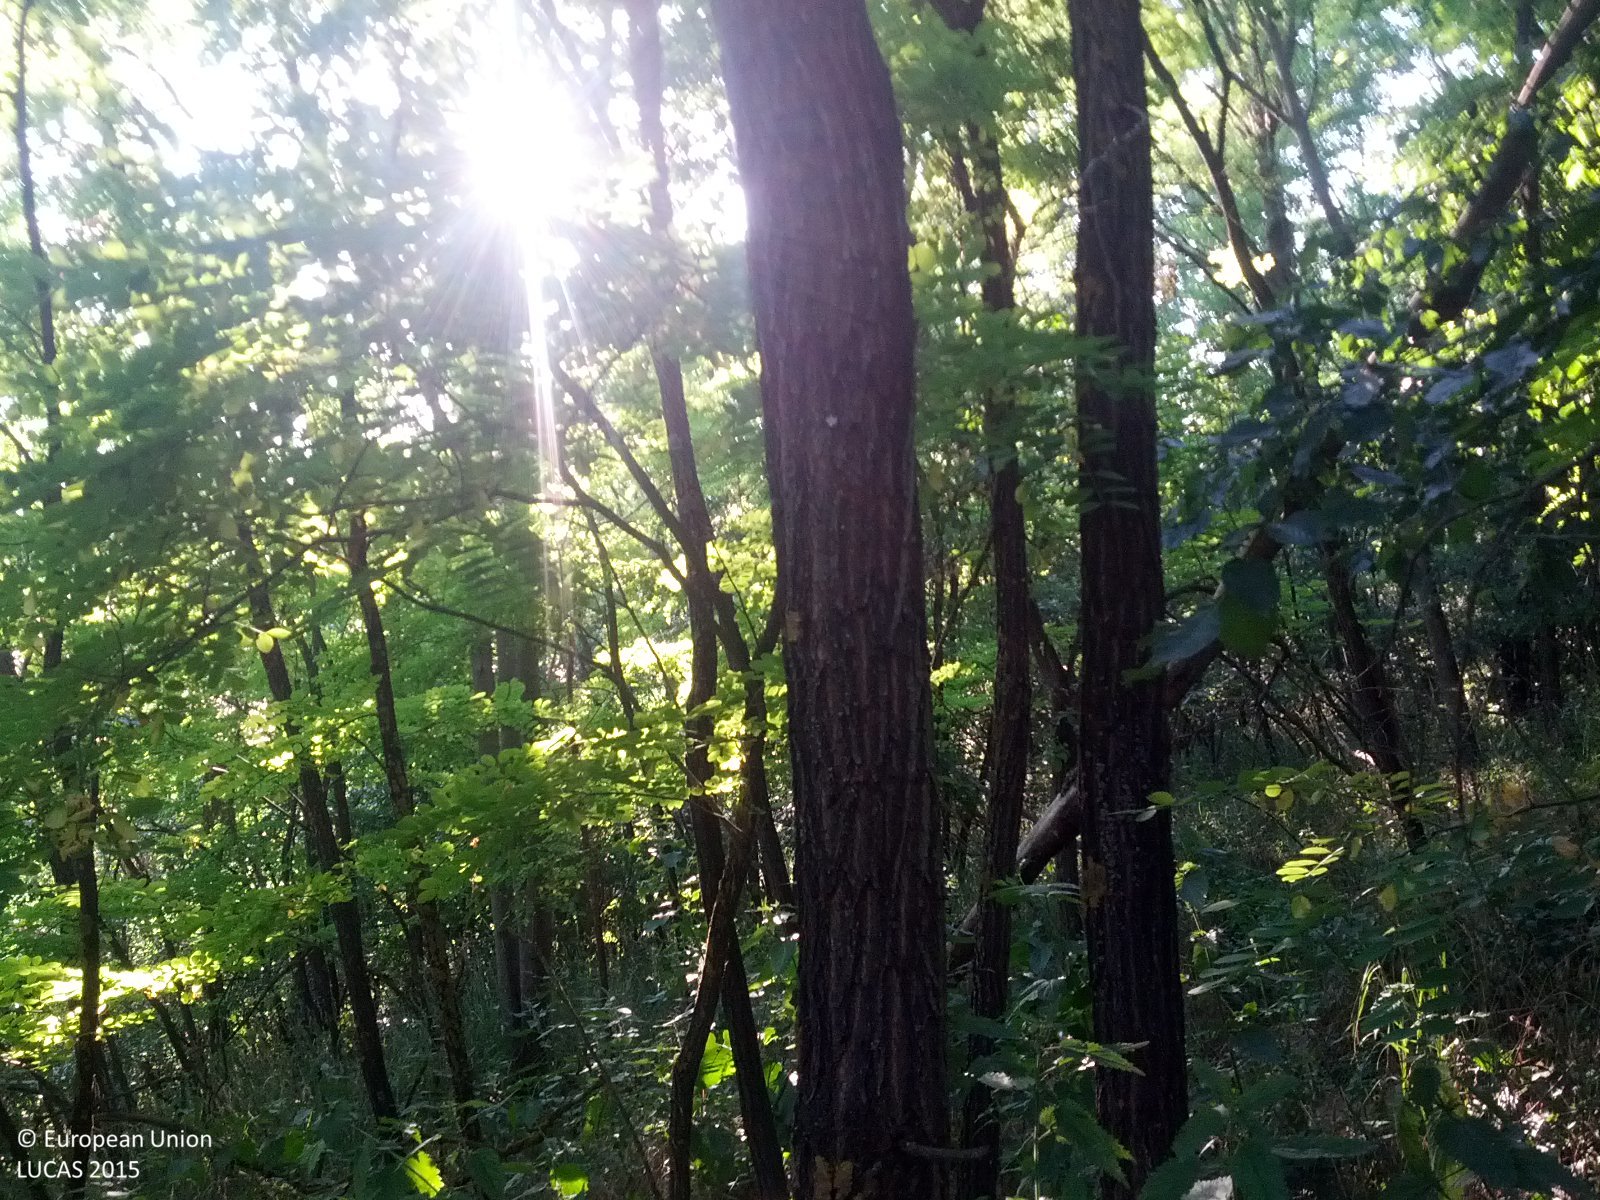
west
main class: Woodland
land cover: Broadleaved woodland
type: mesophytic deciduous forest
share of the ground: > 75 %
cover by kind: broadleaved forest trees 90 %, herbaceous plants 10 %
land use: Forestry
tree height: > 5 m
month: July
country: AT
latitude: 48.3862
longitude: 16.6095
